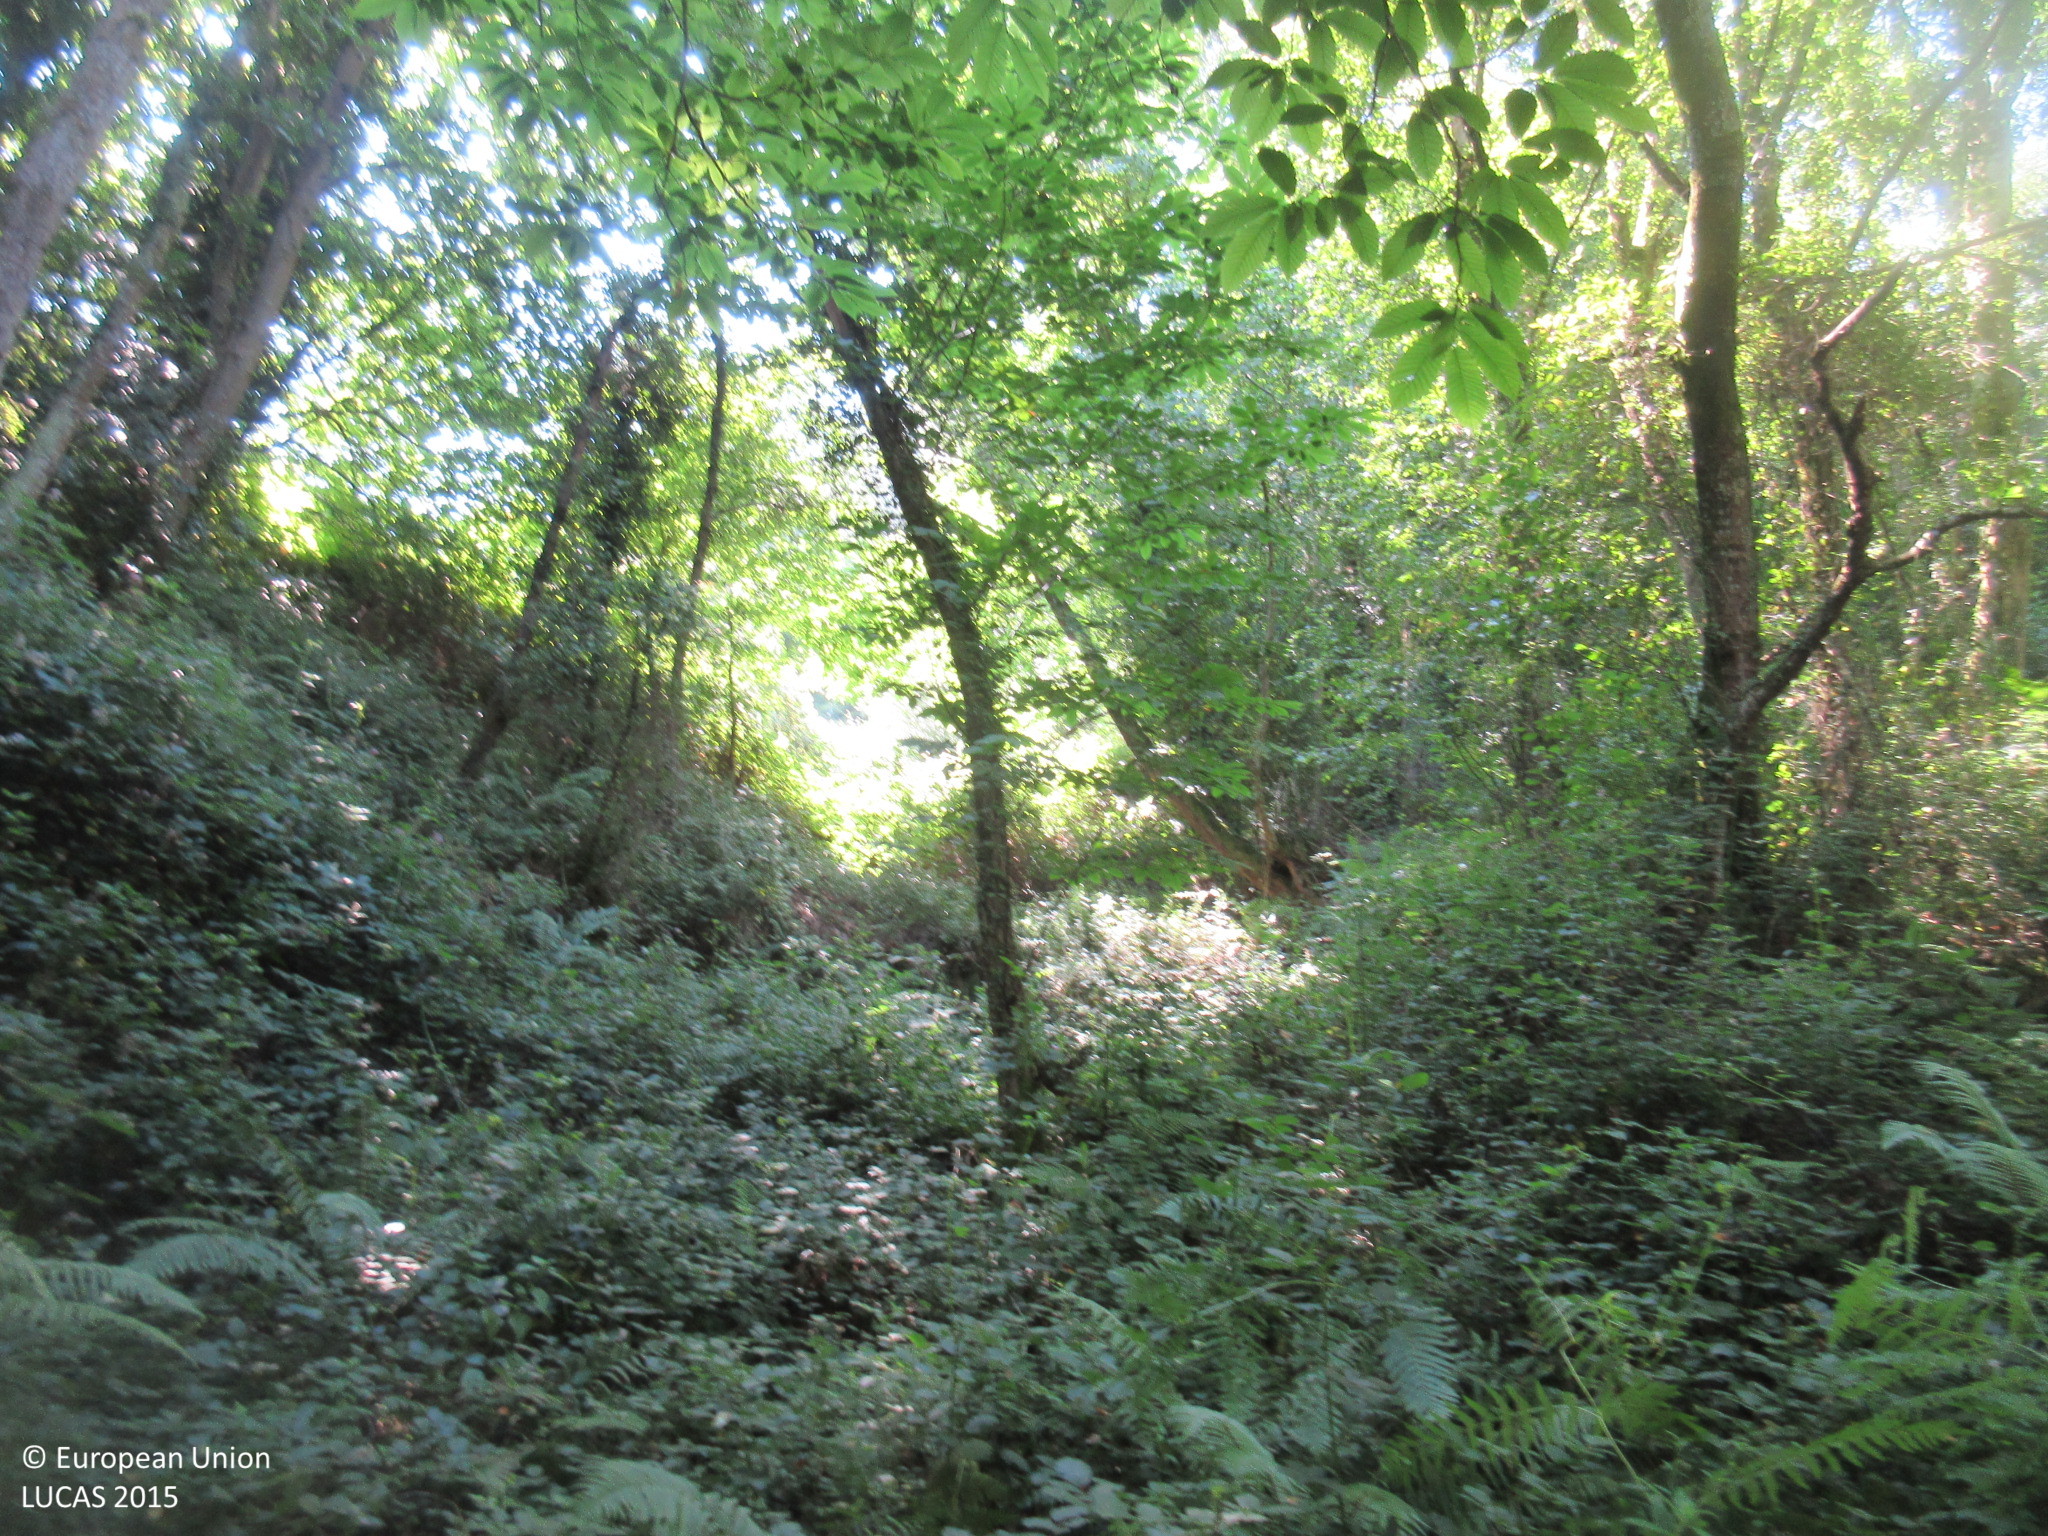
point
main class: Woodland
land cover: Broadleaved woodland
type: thermophilous deciduous forest
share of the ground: > 75 %
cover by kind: broadleaved forest trees 100 %
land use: Forestry
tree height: > 5 m
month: July
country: ES
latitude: 43.4782
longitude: -6.6118
